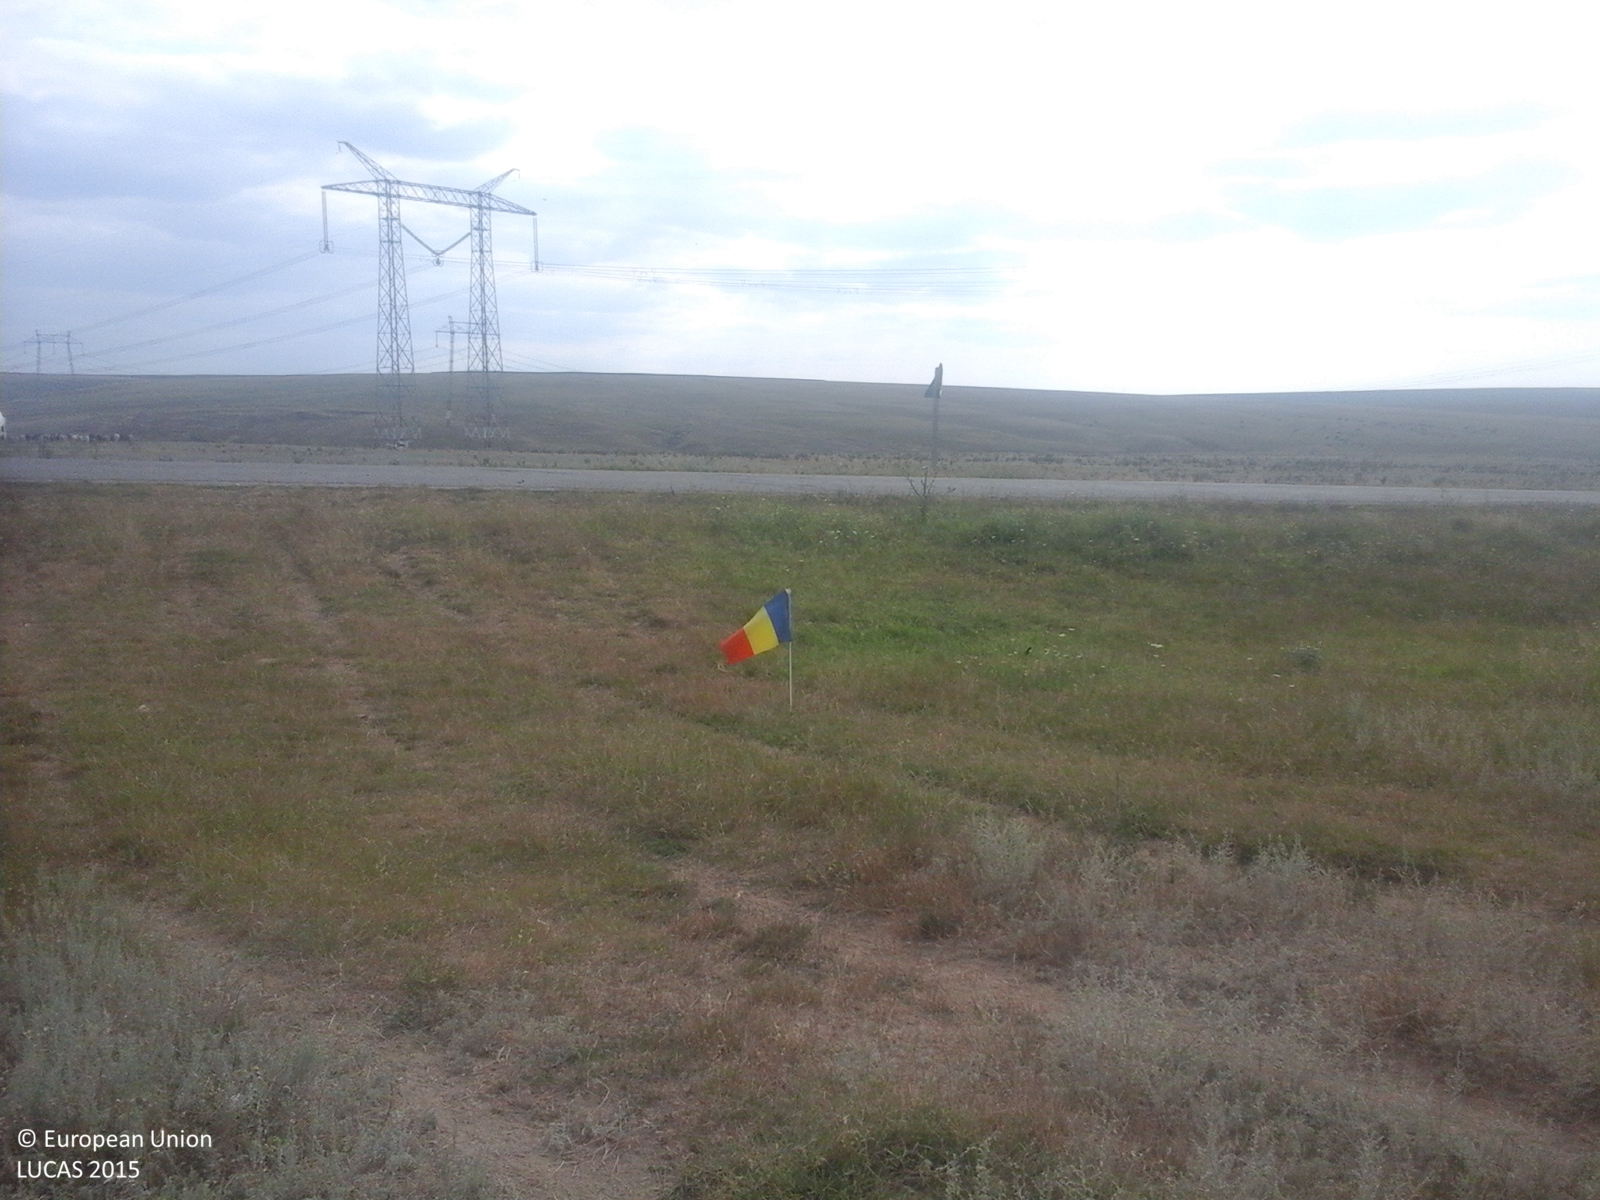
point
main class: Grassland
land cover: Grassland without tree/shrub cover
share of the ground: > 75 %
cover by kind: herbaceous plants 100 %
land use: Agriculture (excluding fallow land and kitchen gardens)
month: August
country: RO
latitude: 44.7117
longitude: 28.2307
